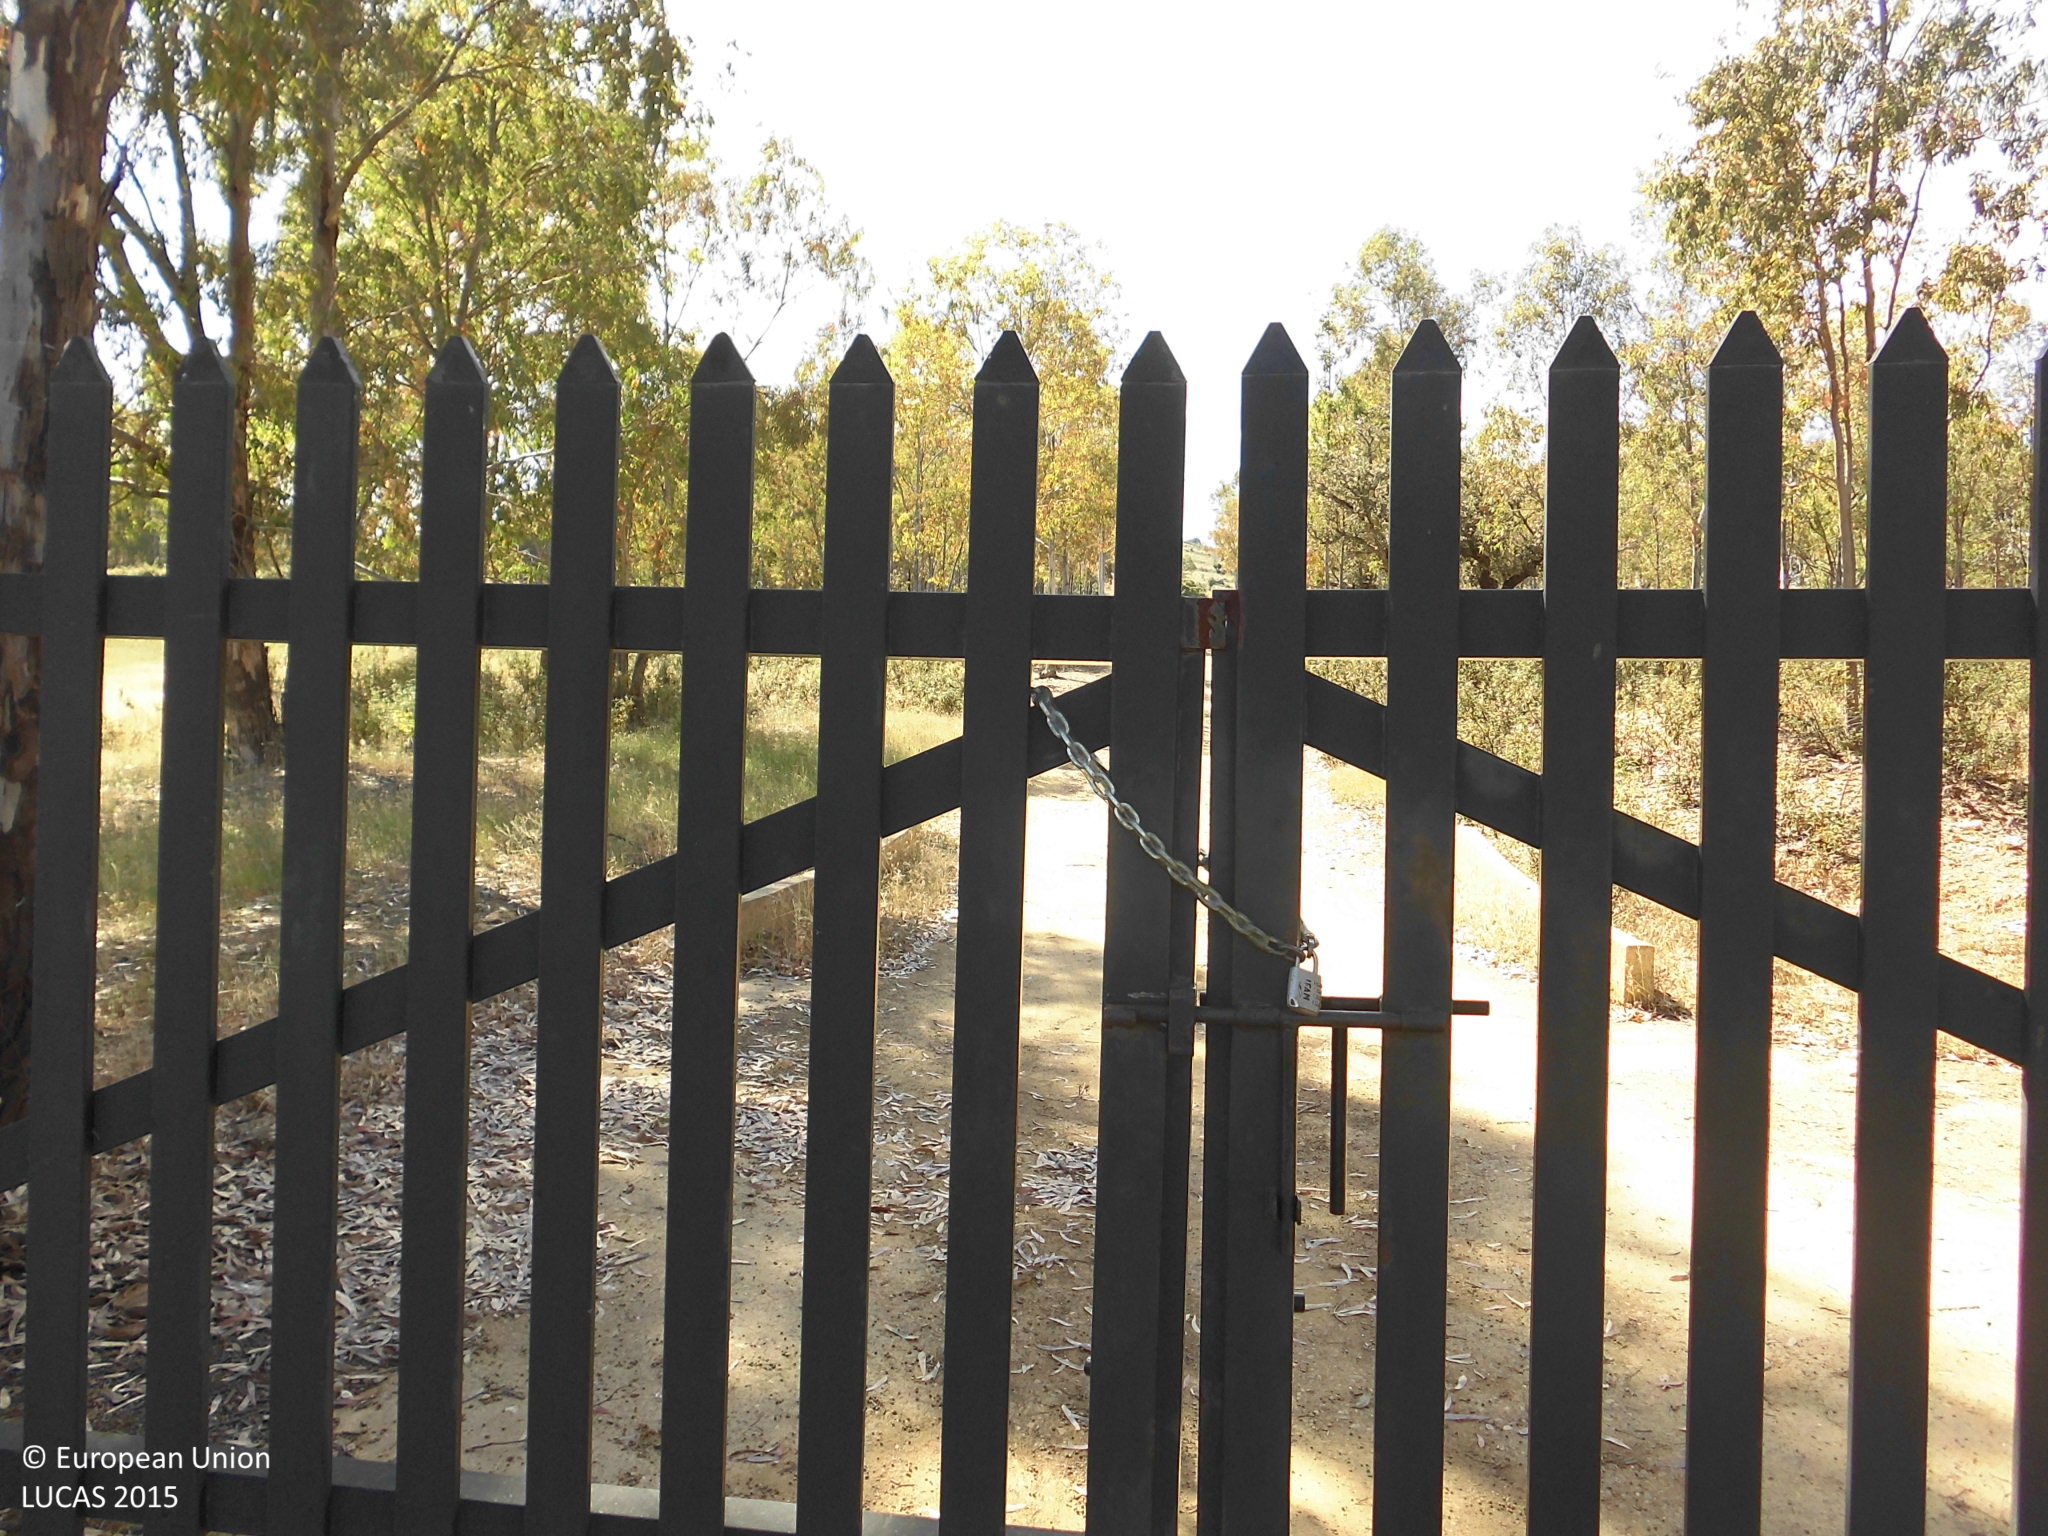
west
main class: Grassland
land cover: Grassland with sparse tree/shrub cover
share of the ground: > 75 %
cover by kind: herbaceous plants 85 %, consolidated bare surface 10 %, broadleaved forest trees 5 %
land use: Agriculture (excluding fallow land and kitchen gardens)
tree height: > 5 m
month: May
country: ES
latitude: 39.9694
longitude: -6.7927
